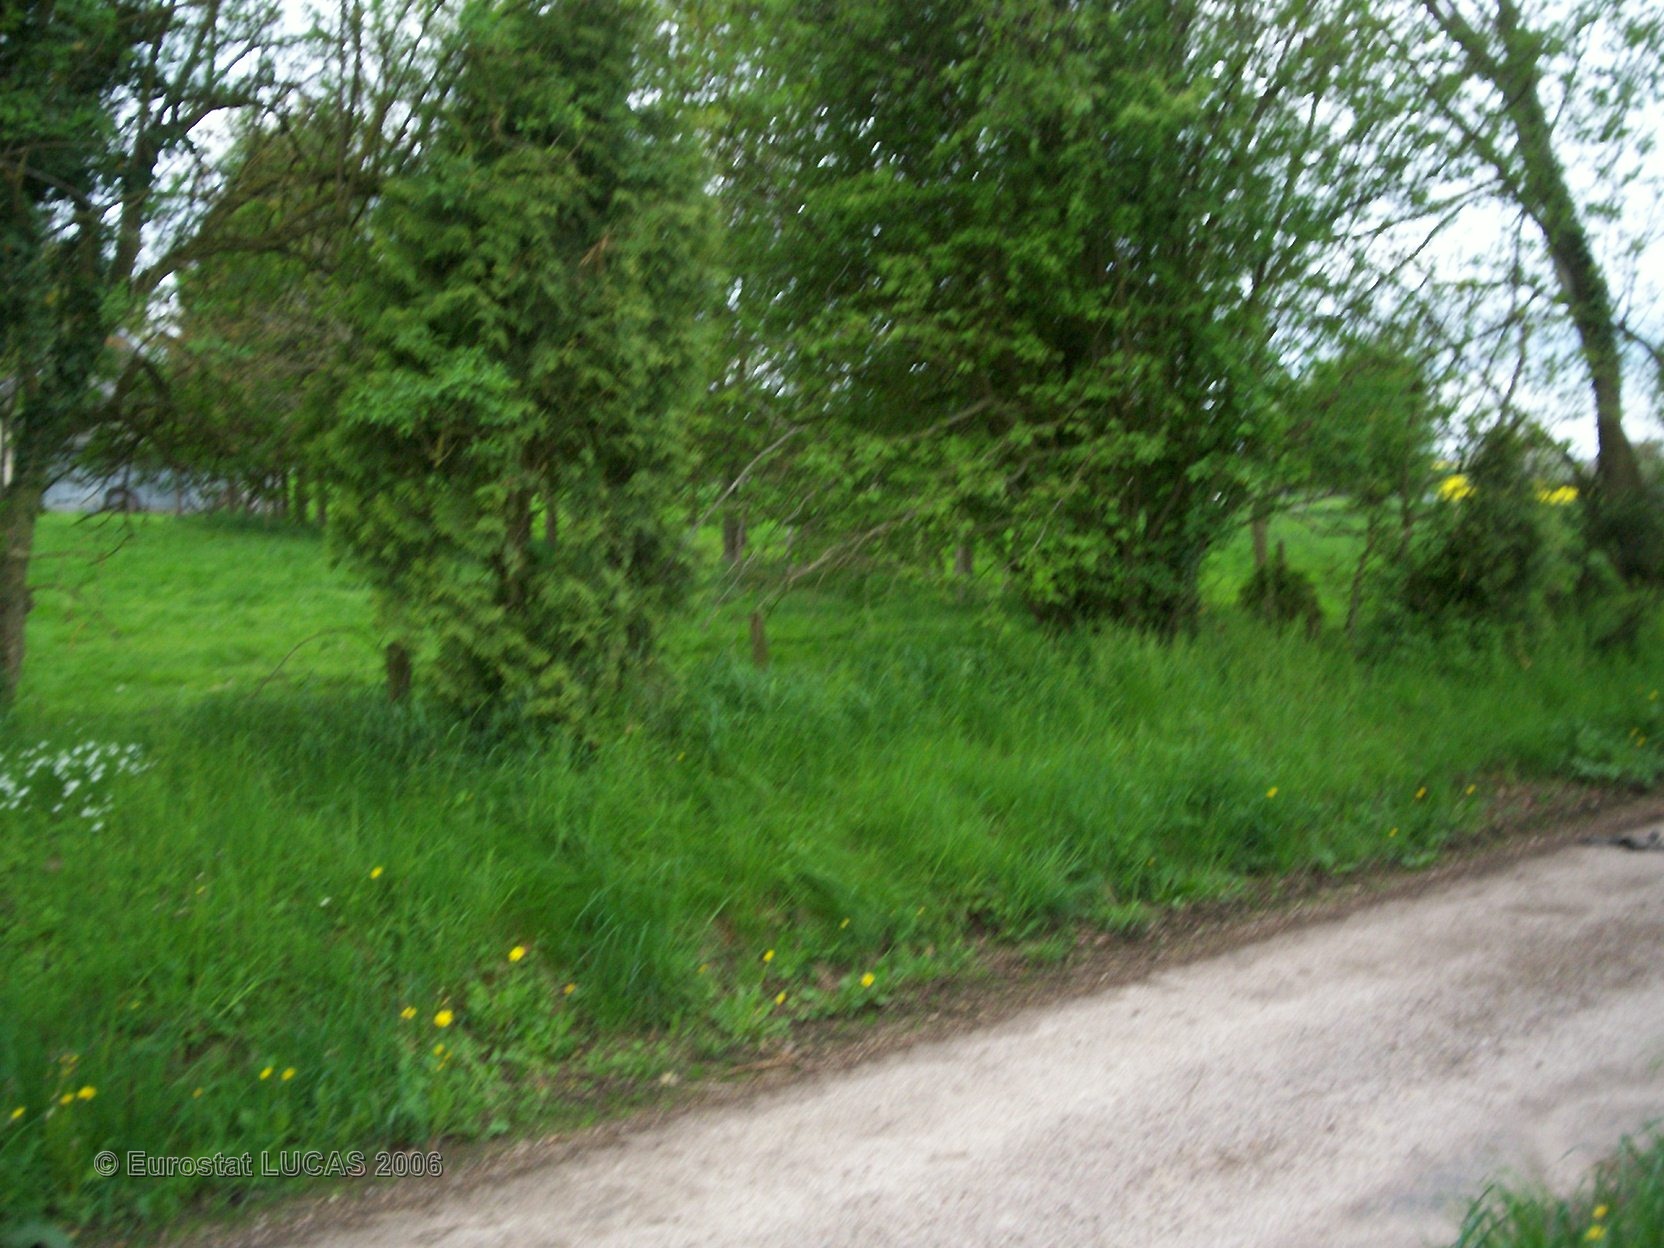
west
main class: Grassland
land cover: Grassland without tree/shrub cover
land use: Agriculture (excluding fallow land and kitchen gardens)
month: May
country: FR
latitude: 49.1172
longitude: 0.5065
